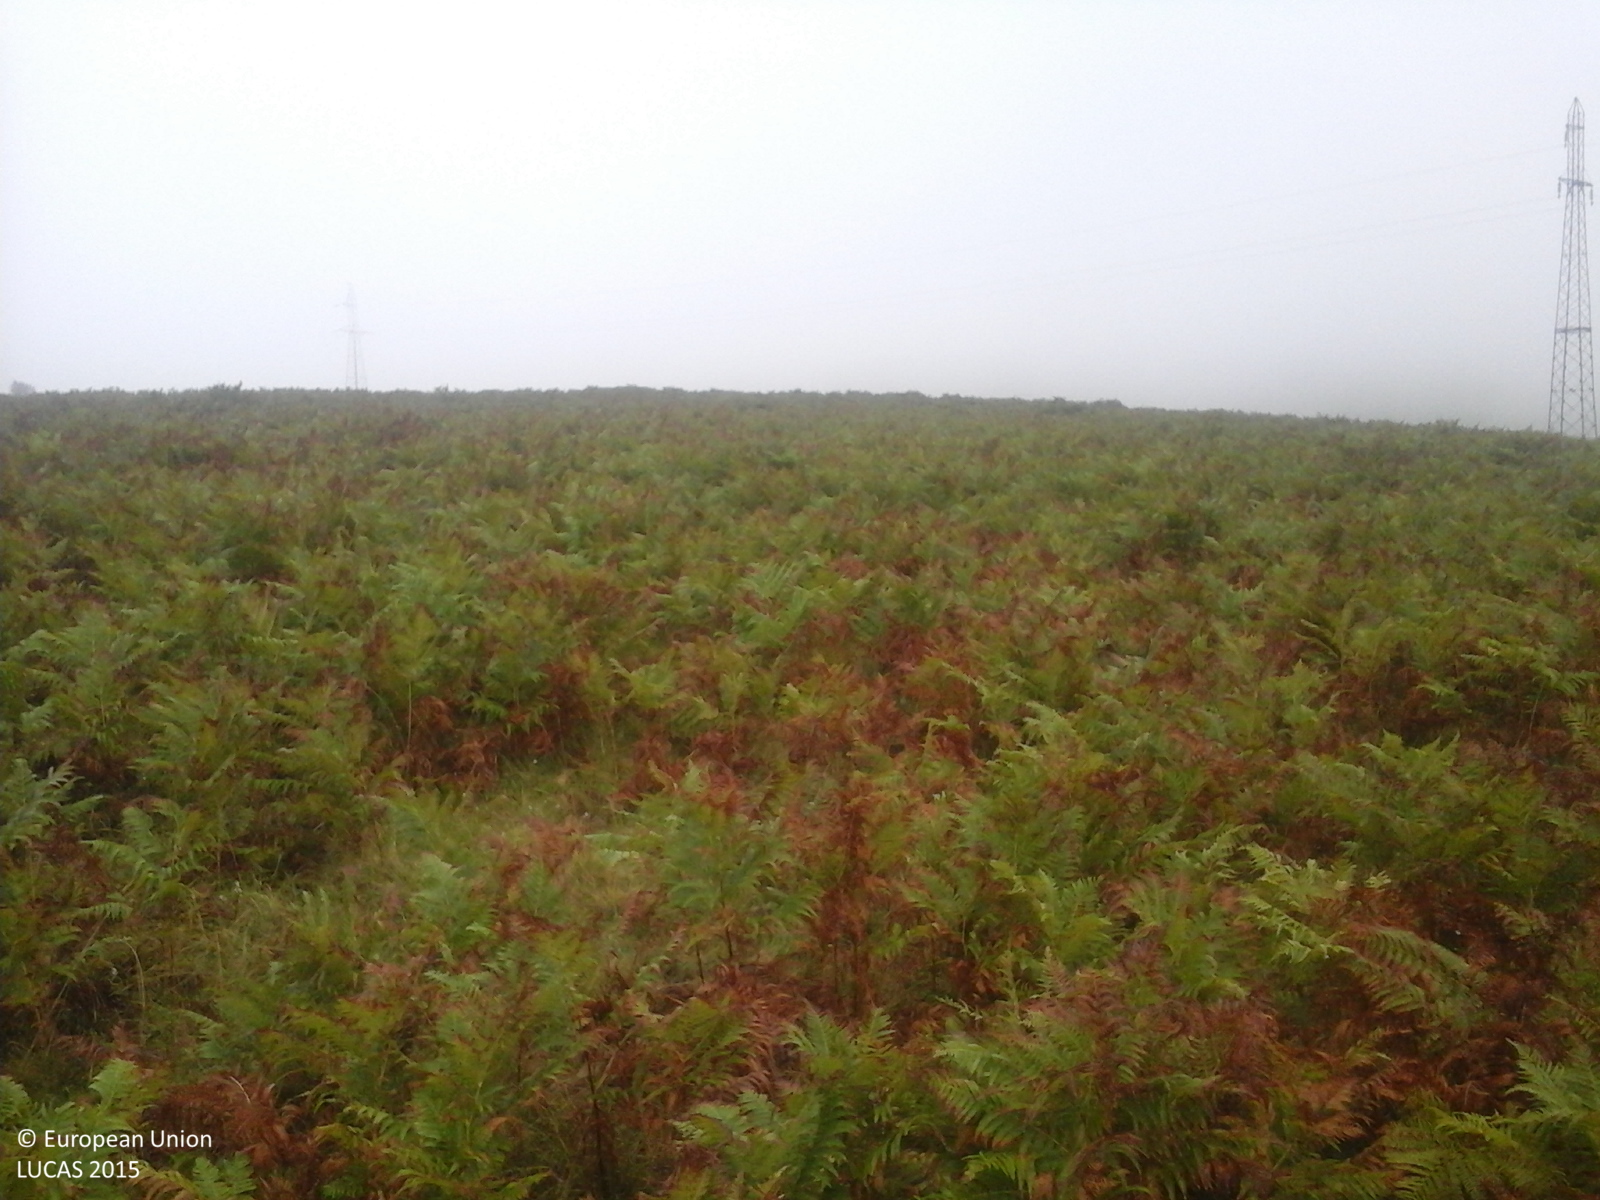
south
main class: Grassland
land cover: Spontaneously vegetated surfaces
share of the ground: > 75 %
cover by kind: herbaceous plants 100 %
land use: Agriculture (excluding fallow land and kitchen gardens)
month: September
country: RO
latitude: 46.9833
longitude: 22.4778
